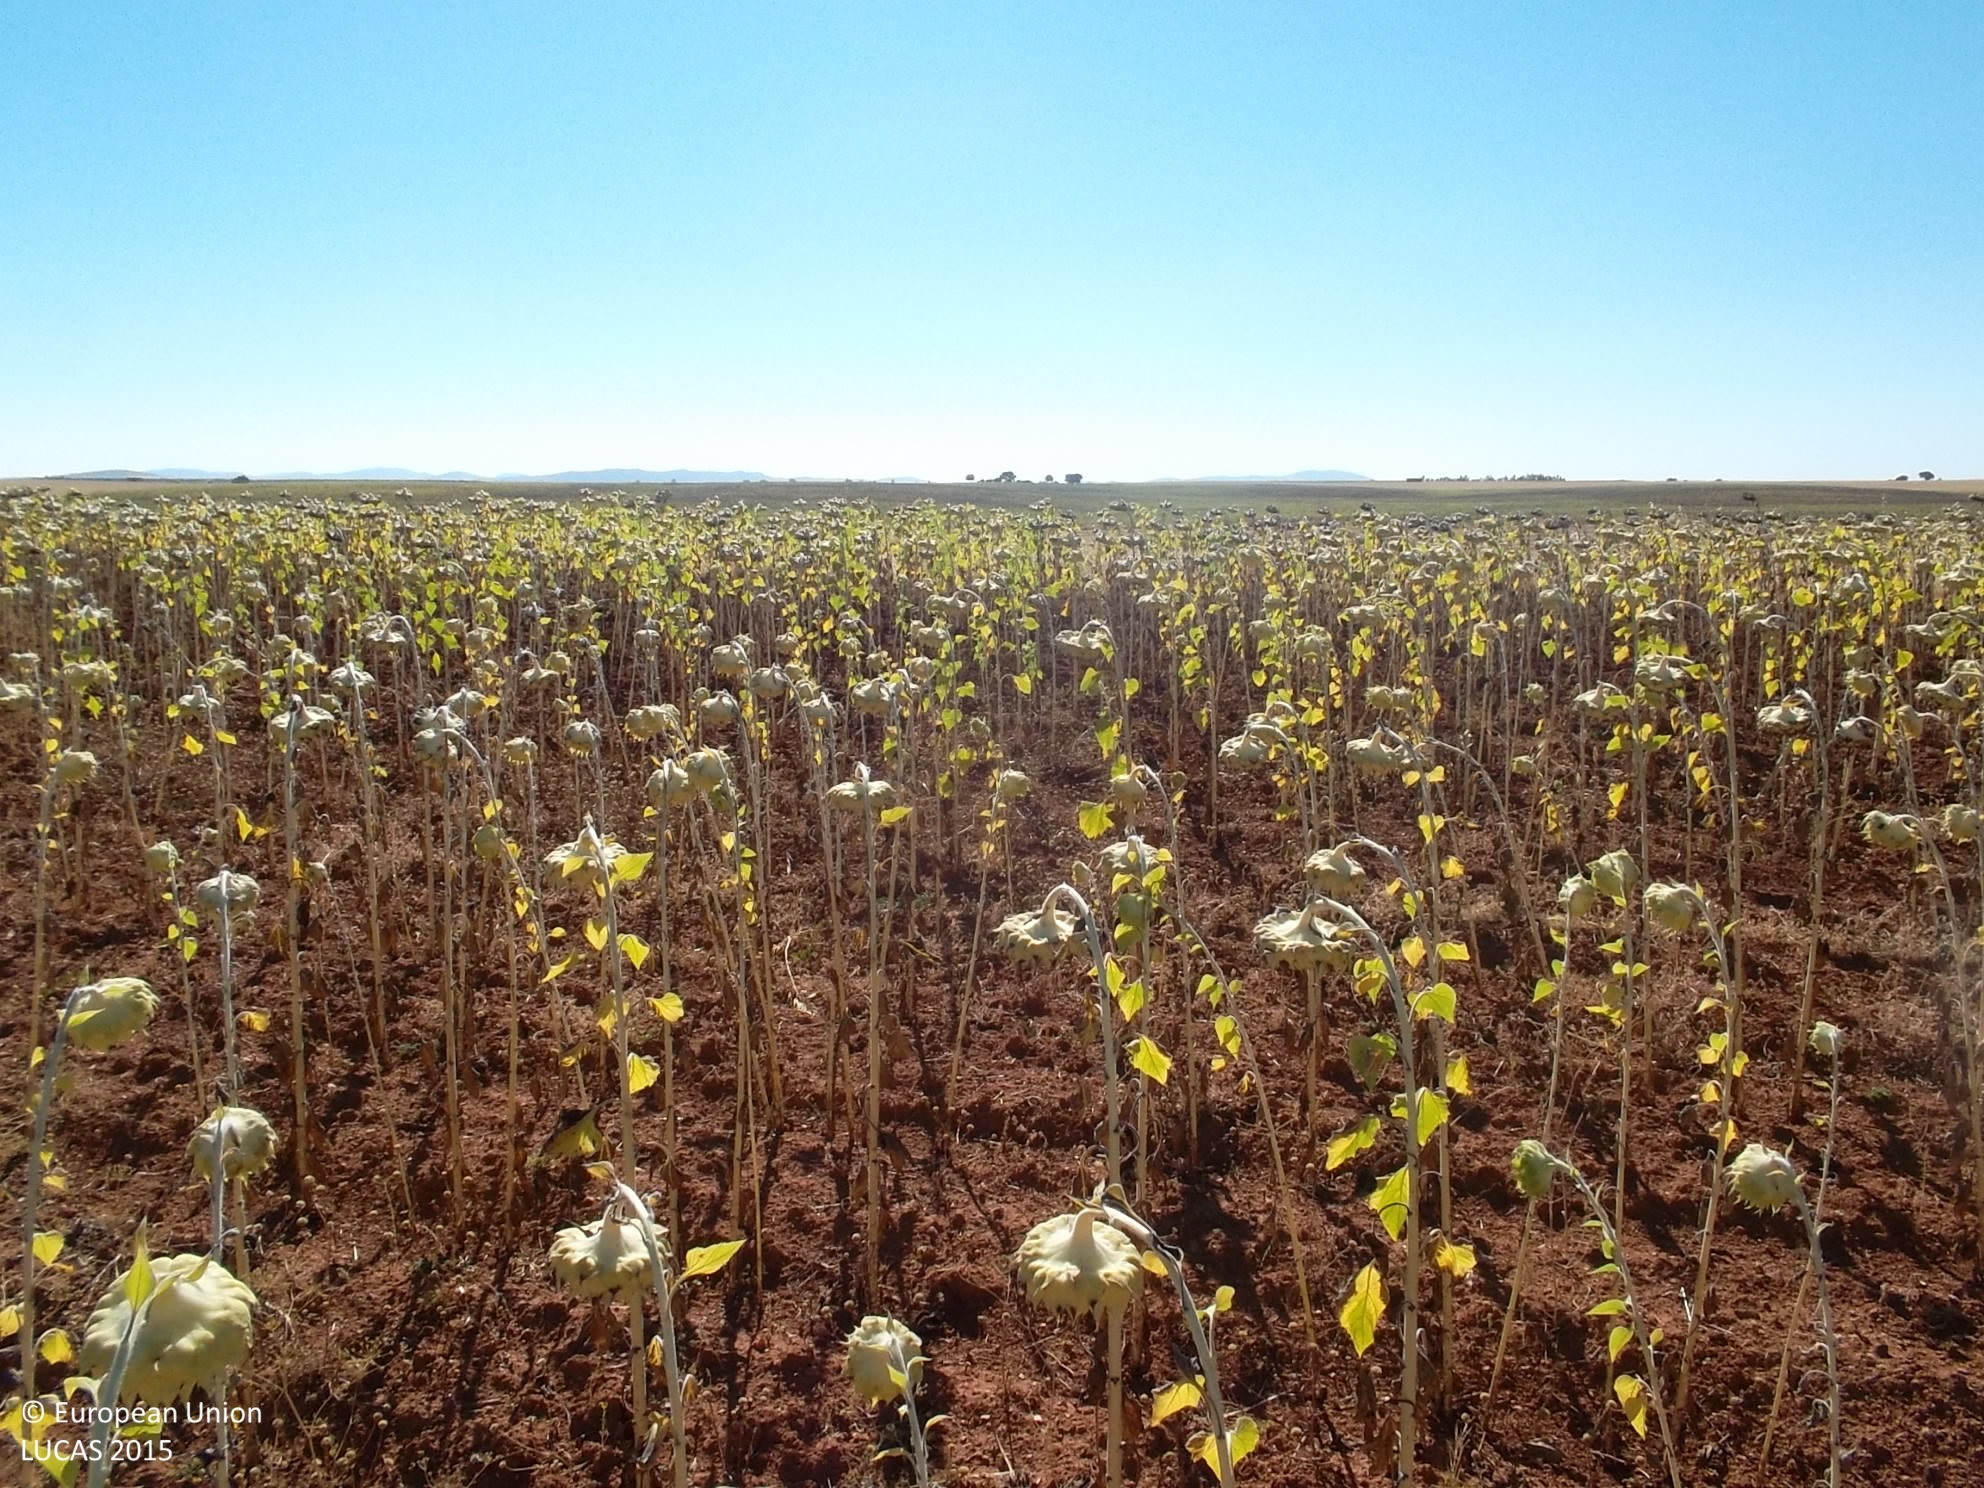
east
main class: Cropland
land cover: Sunflower
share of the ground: > 75 %
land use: Agriculture (excluding fallow land and kitchen gardens)
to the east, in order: Sunflower; Grass margins; Barley; Grass margins; Sunflower
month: July
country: ES
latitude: 38.3819
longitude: -5.7320
